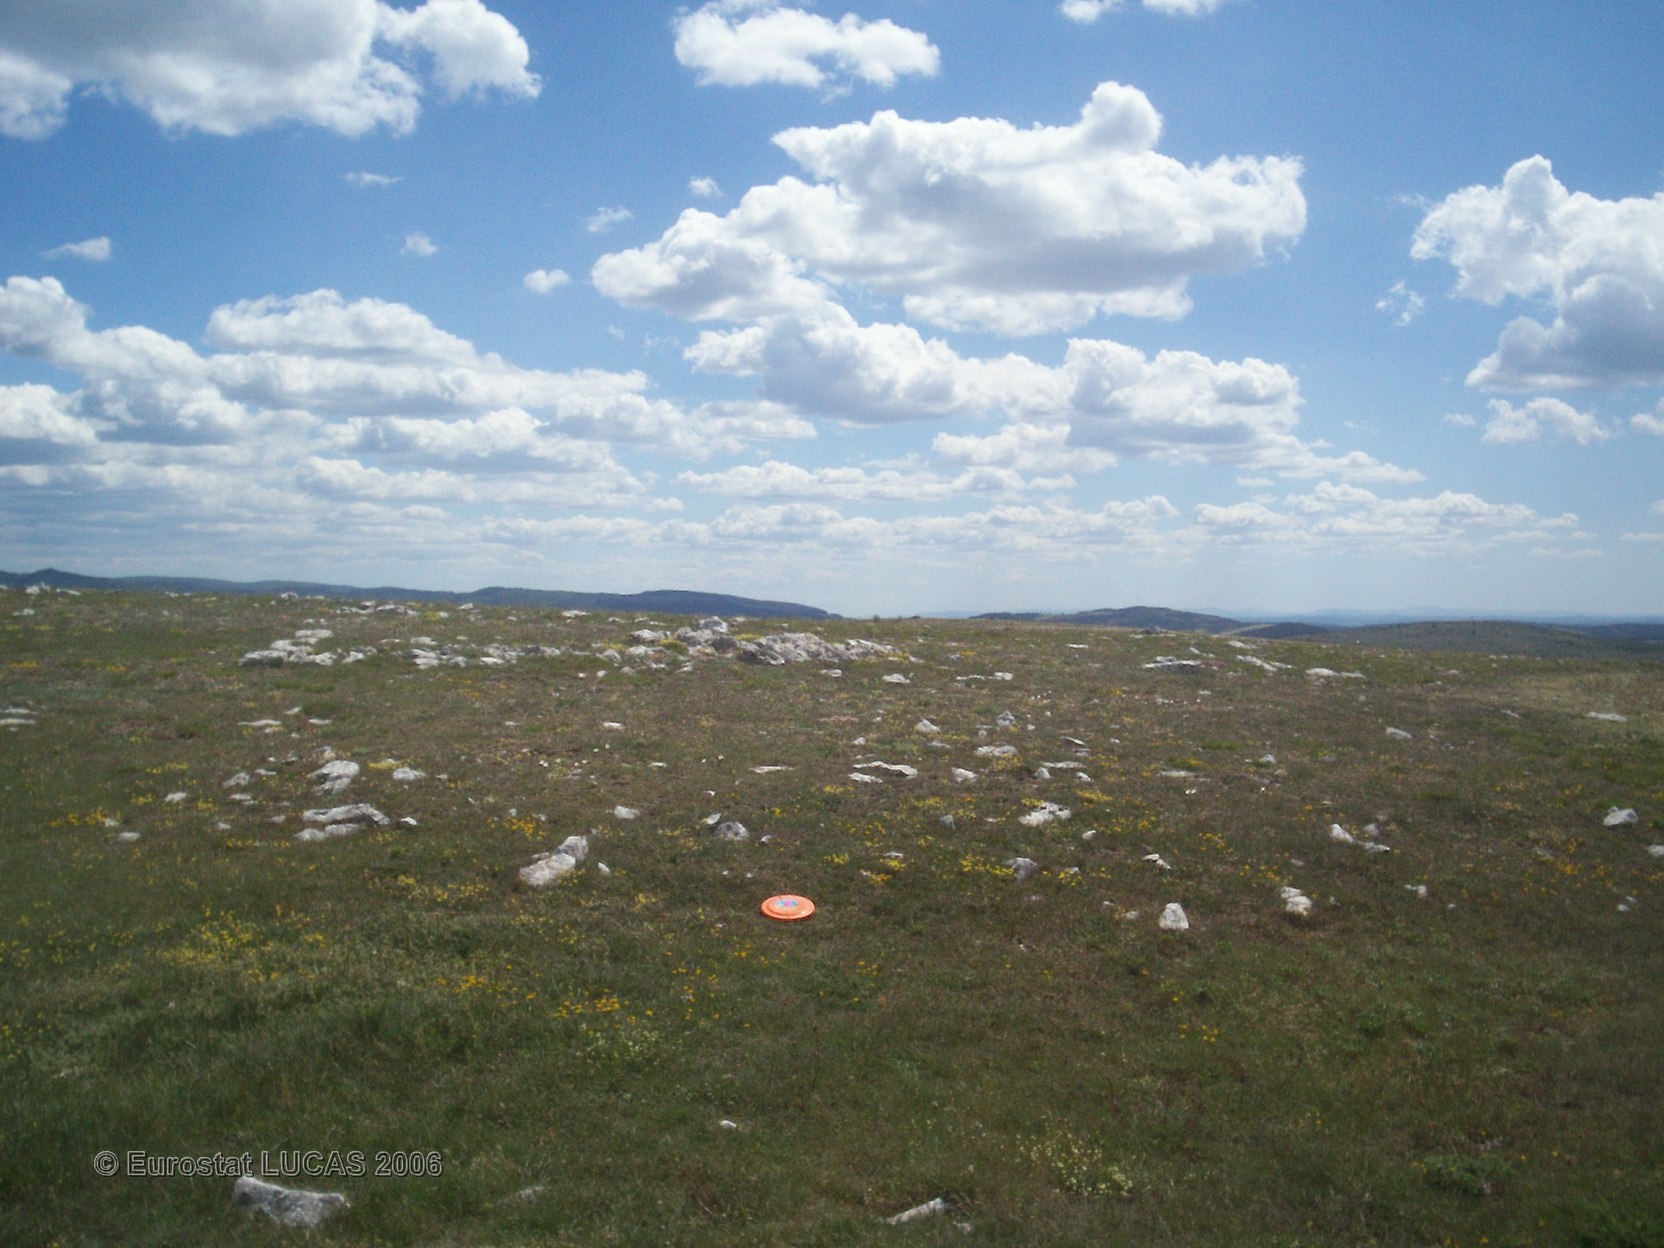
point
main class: Grassland
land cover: Grassland without tree/shrub cover
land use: Agriculture (excluding fallow land and kitchen gardens)
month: June
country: FR
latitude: 44.2165
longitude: 3.4601
